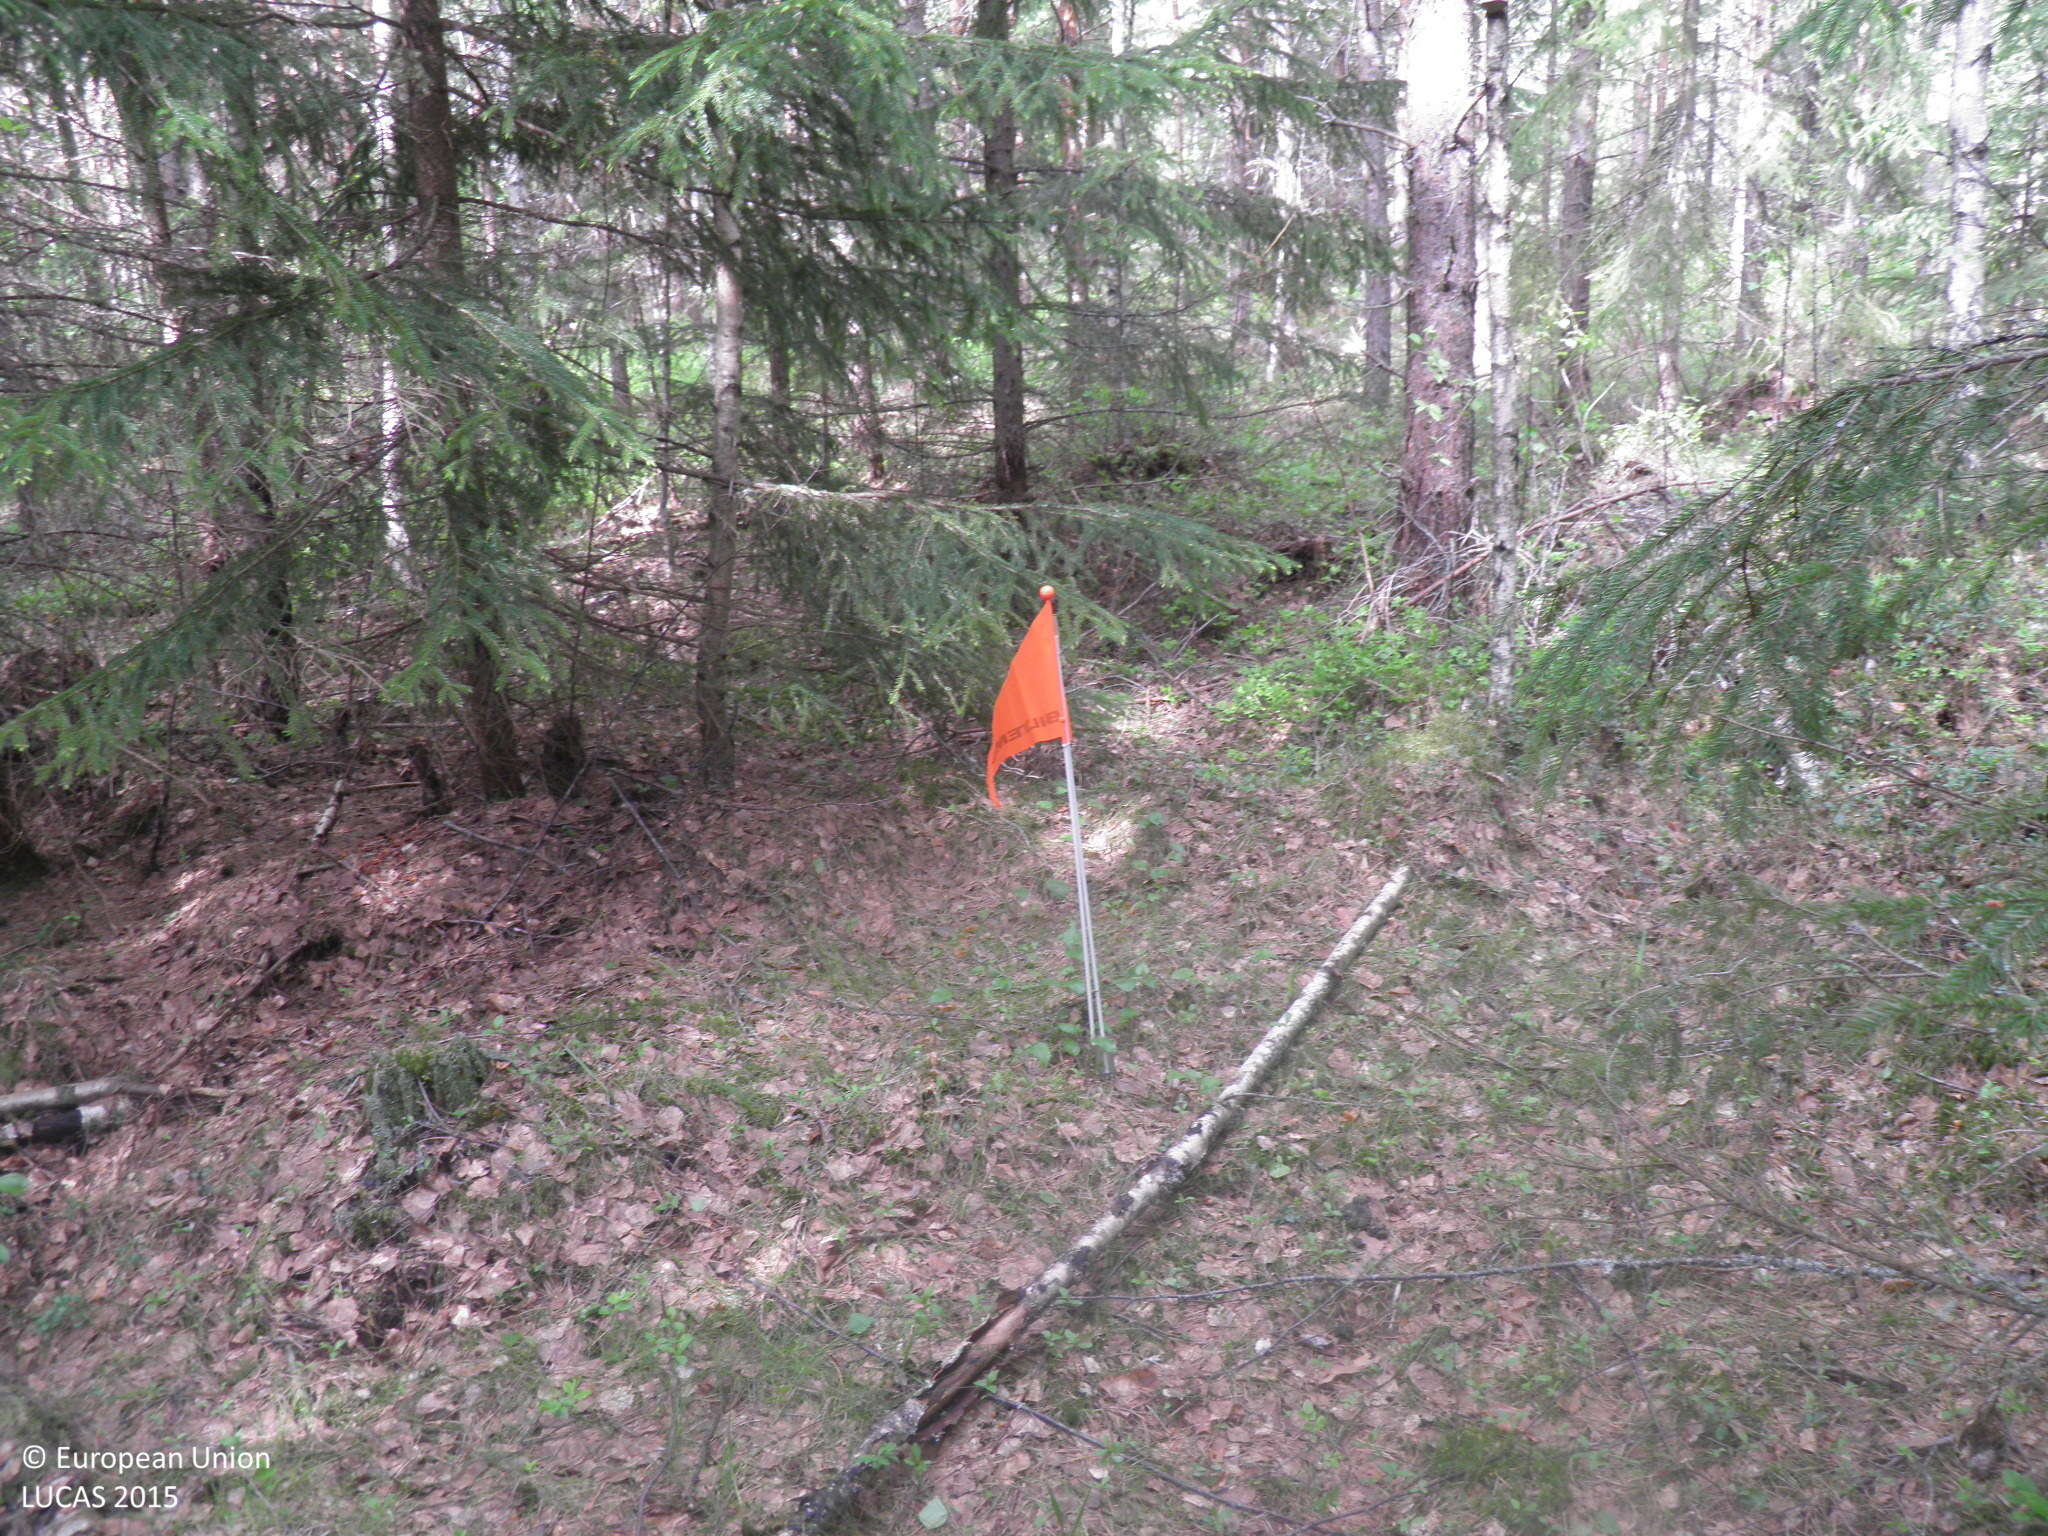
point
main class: Woodland
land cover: Other coniferous woodland
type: boreal forest
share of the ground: > 75 %
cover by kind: coniferous forest trees 70 %, broadleaved forest trees 20 %, shrubs 5 %, lichens and mosses 5 %
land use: Forestry
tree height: > 5 m
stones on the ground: < 10 %
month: June
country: FI
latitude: 60.5625
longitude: 22.6027
